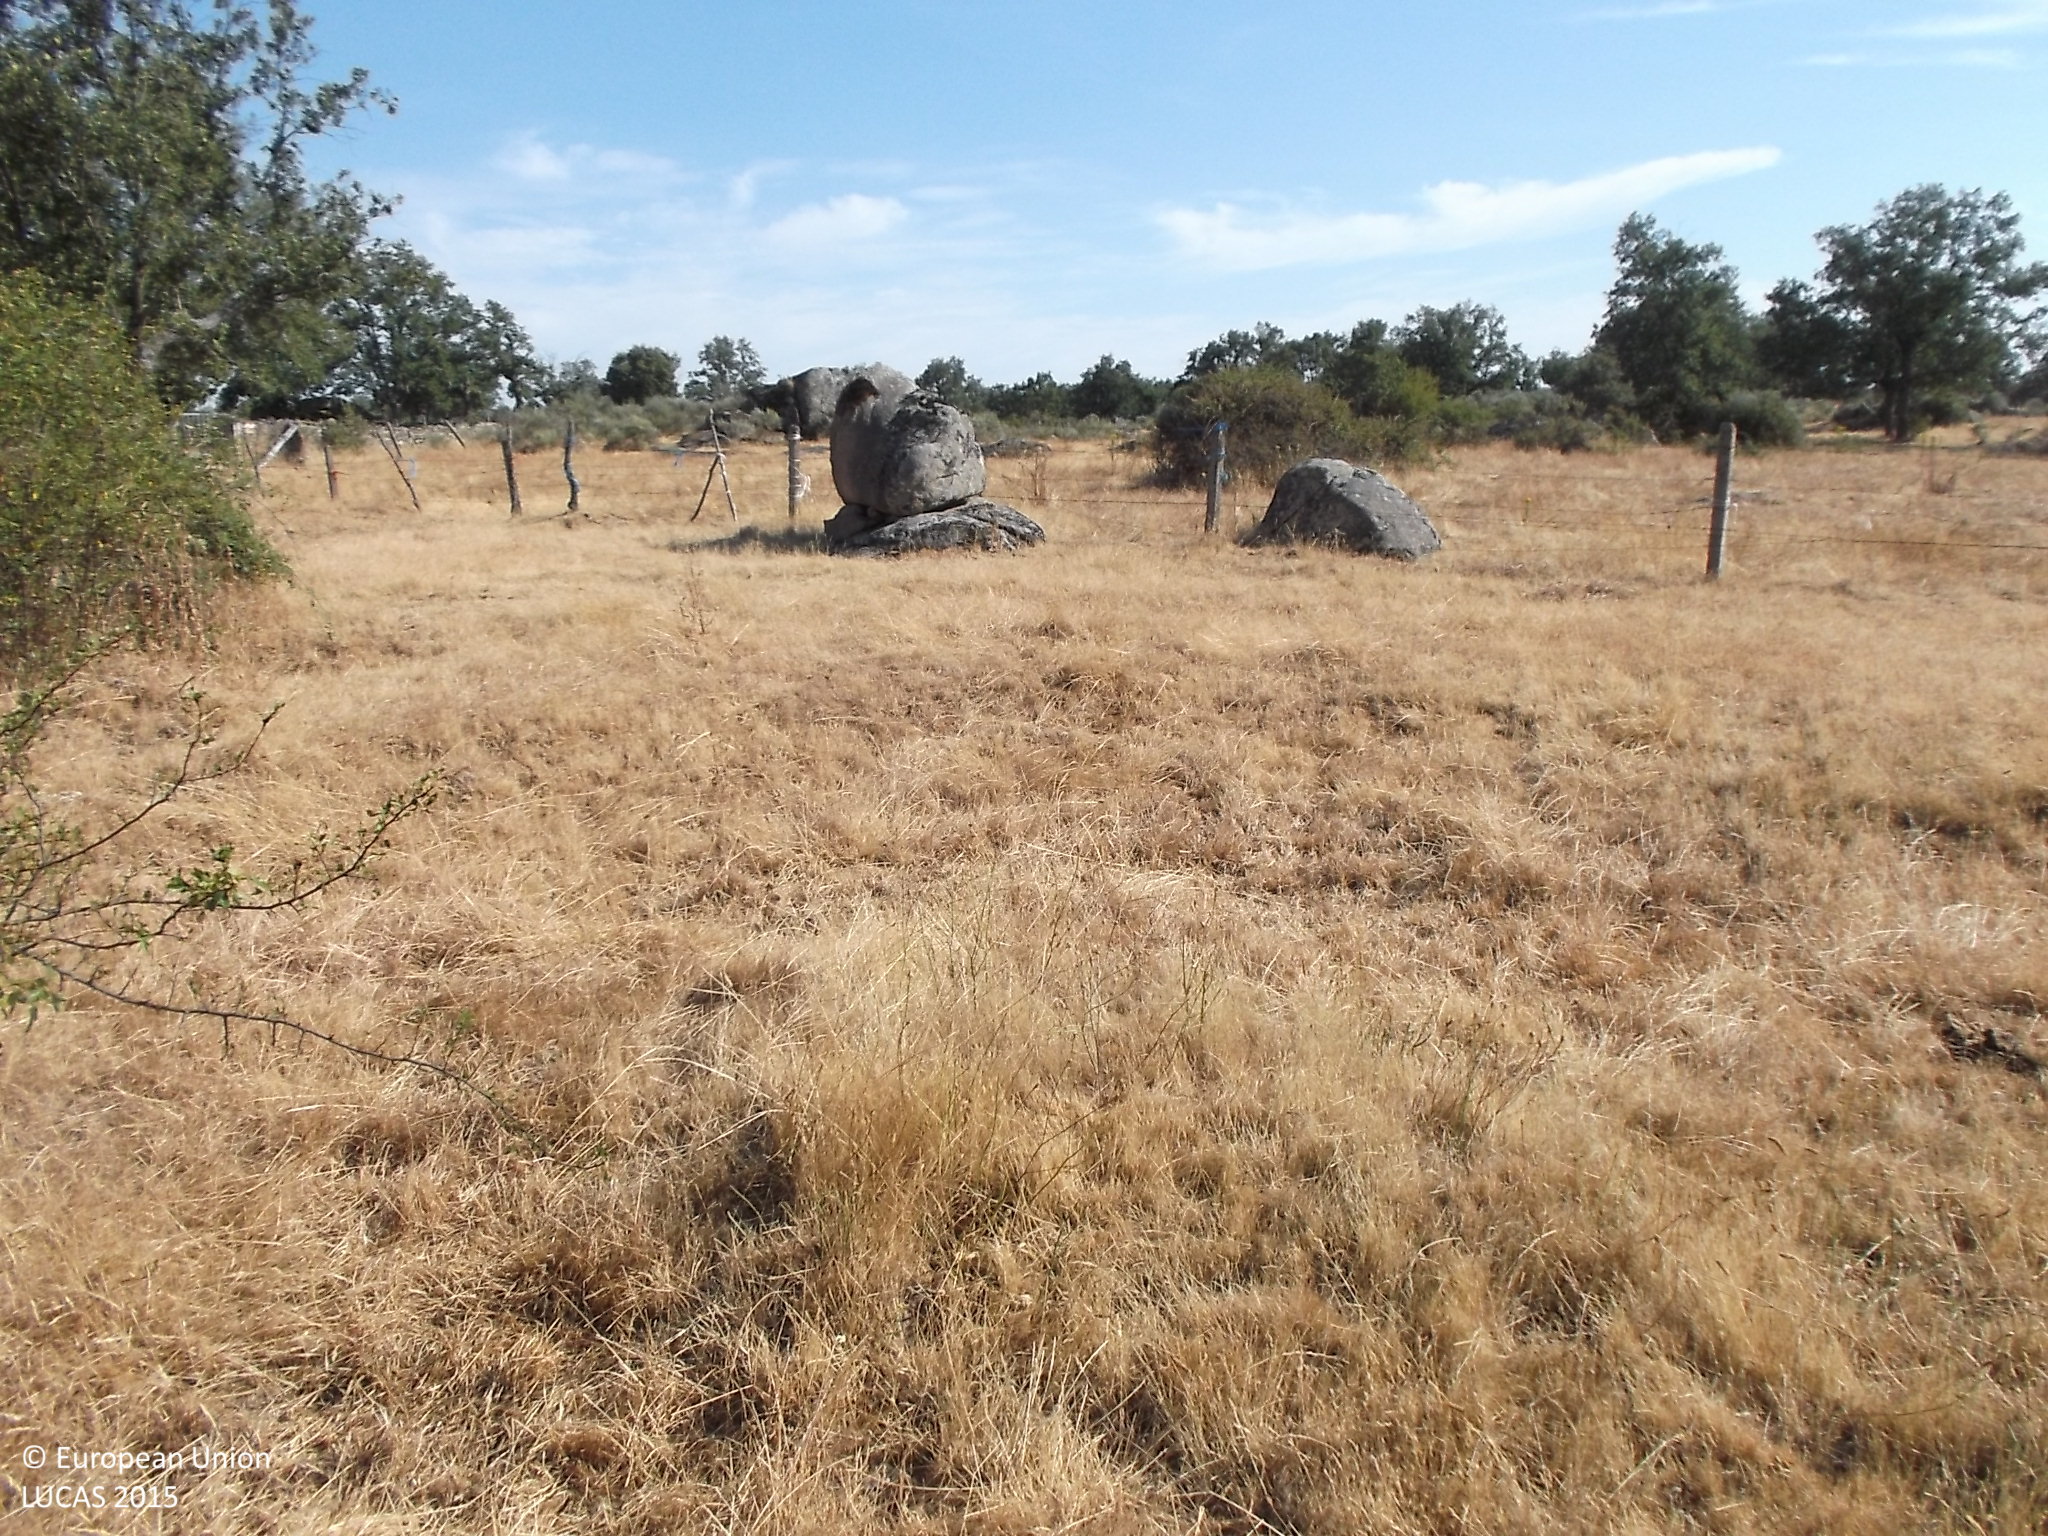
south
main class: Grassland
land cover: Grassland with sparse tree/shrub cover
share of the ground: > 75 %
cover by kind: herbaceous plants 90 %, broadleaved forest trees 5 %, shrubs 5 %
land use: Agriculture (excluding fallow land and kitchen gardens)
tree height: < 5 m
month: July
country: ES
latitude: 41.1147
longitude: -6.4471
